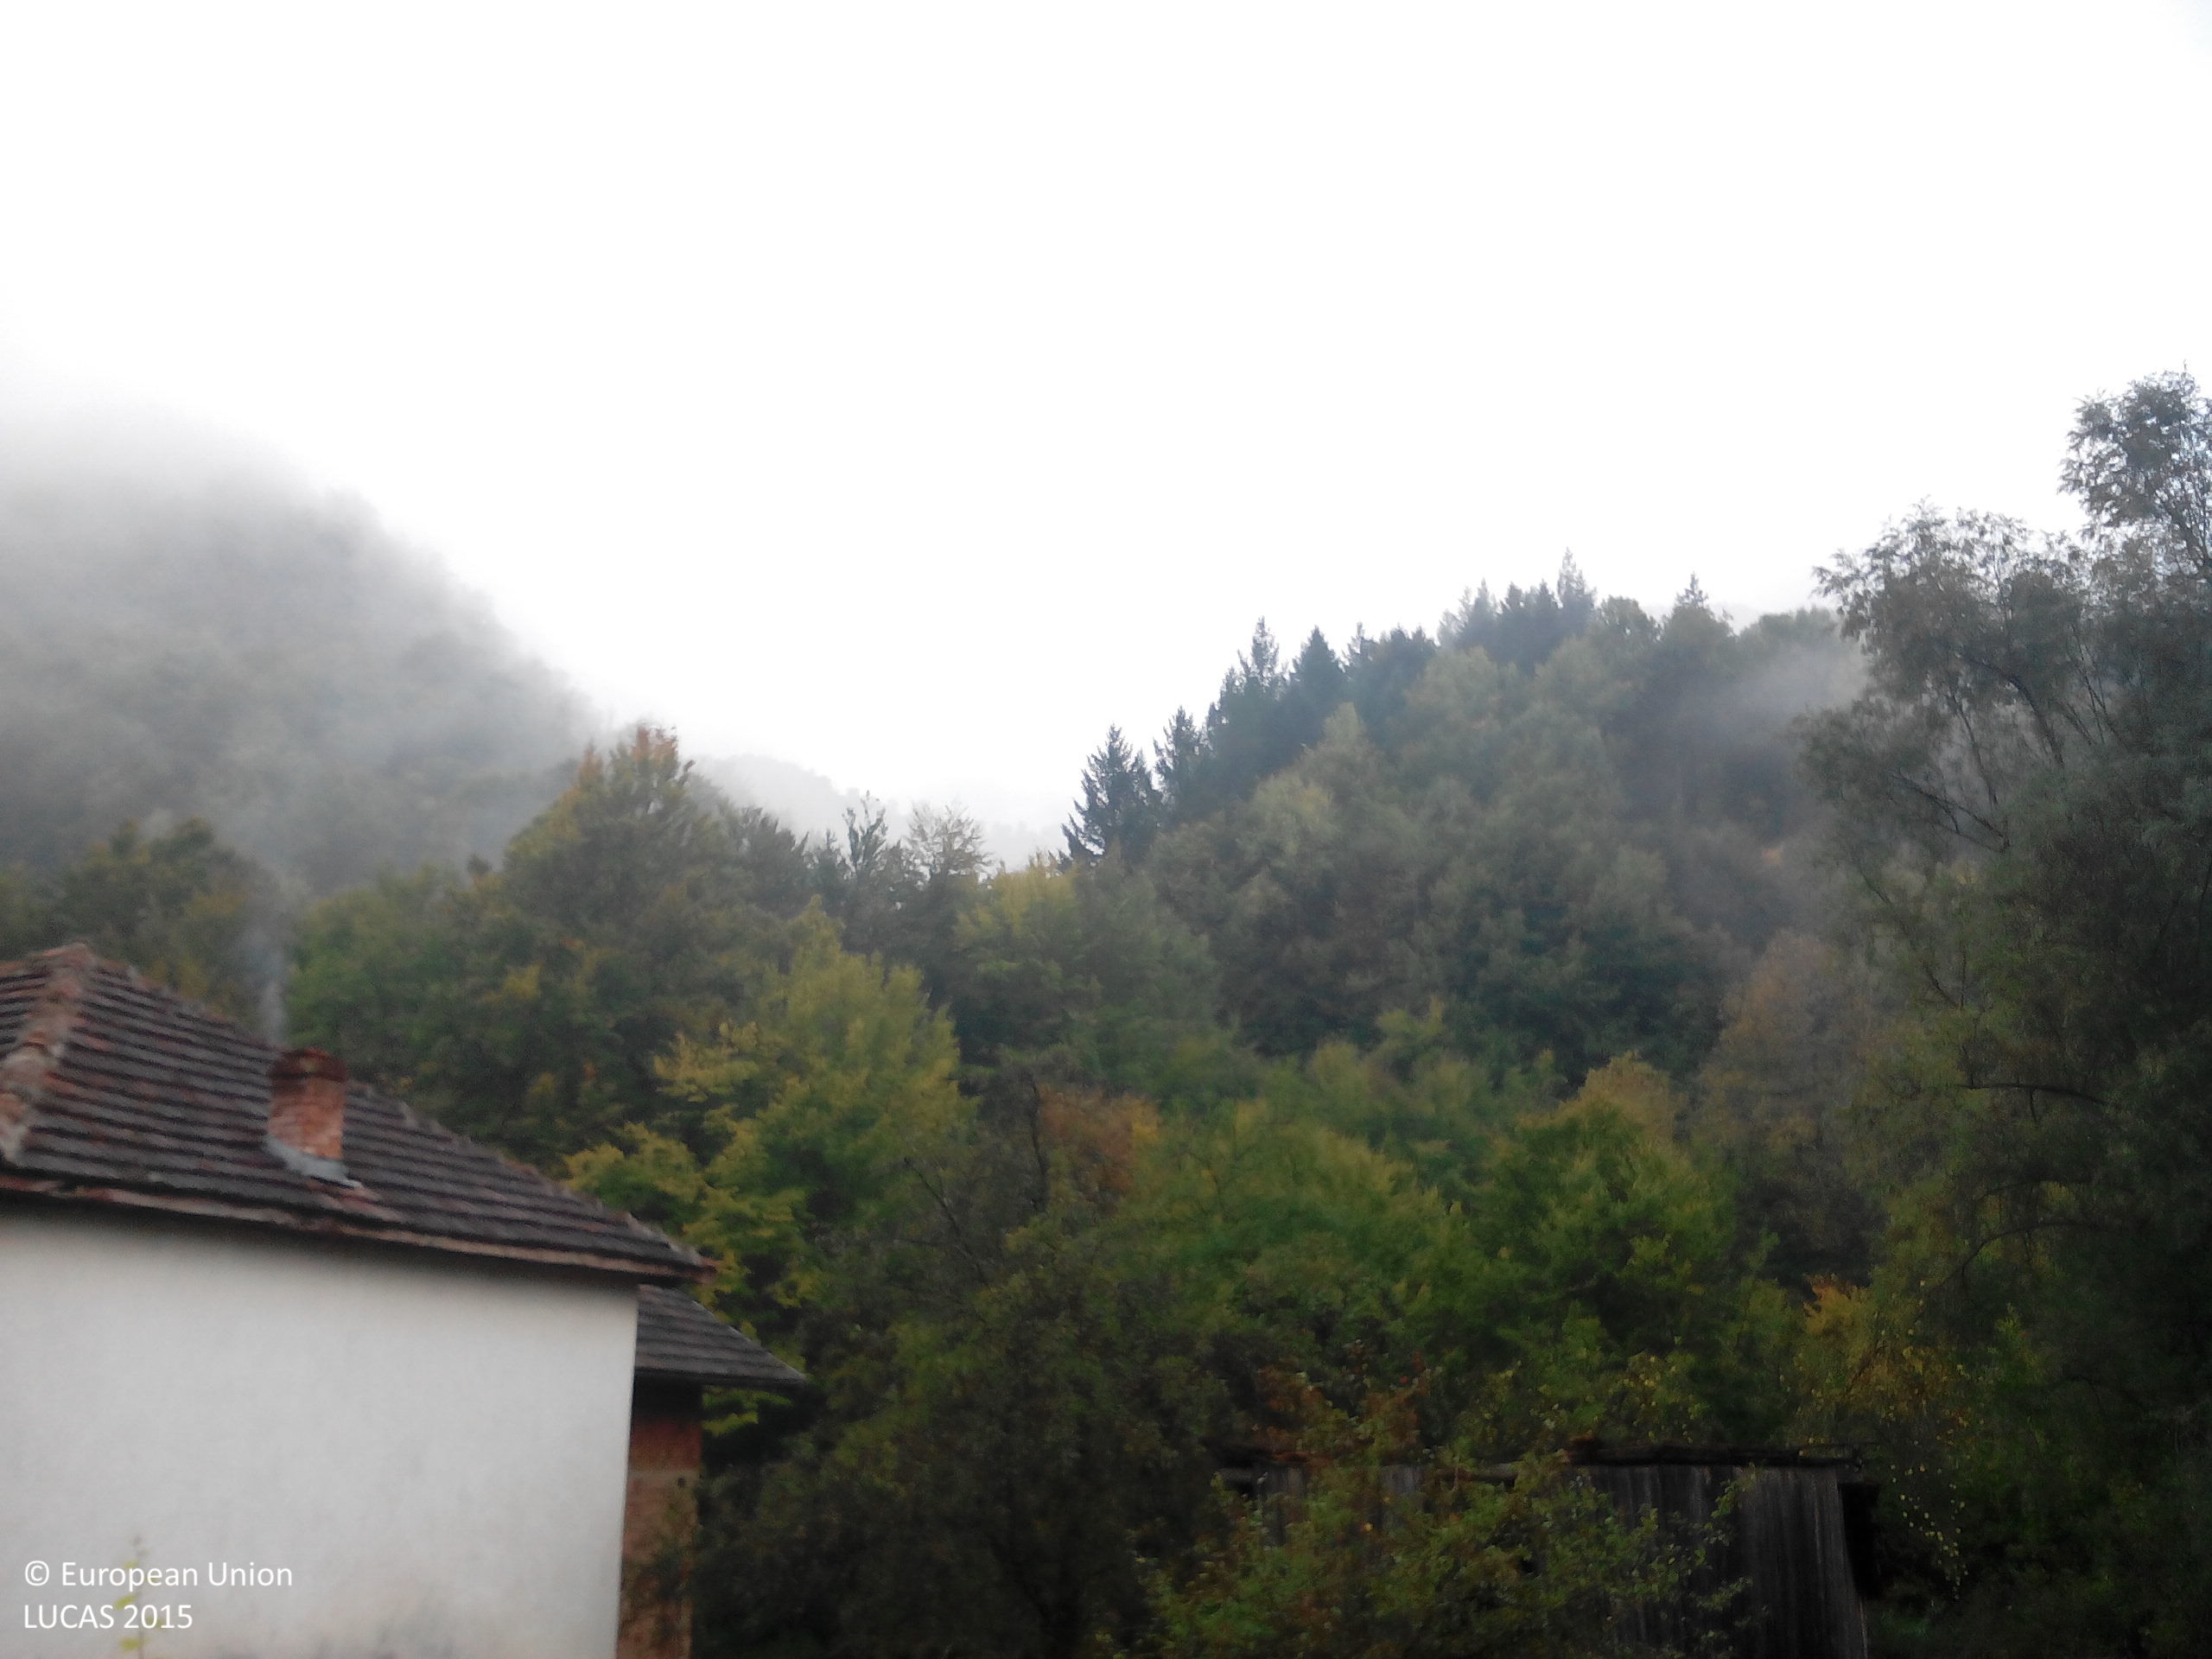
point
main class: Woodland
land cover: Other mixed woodland
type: hemiboreal forest and nemoral coniferous forest and mixed broadleaved-coniferous forest
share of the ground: > 75 %
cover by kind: coniferous forest trees 50 %, broadleaved forest trees 50 %
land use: Forestry
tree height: > 5 m
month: October
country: BG
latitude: 42.8695
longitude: 24.3622
